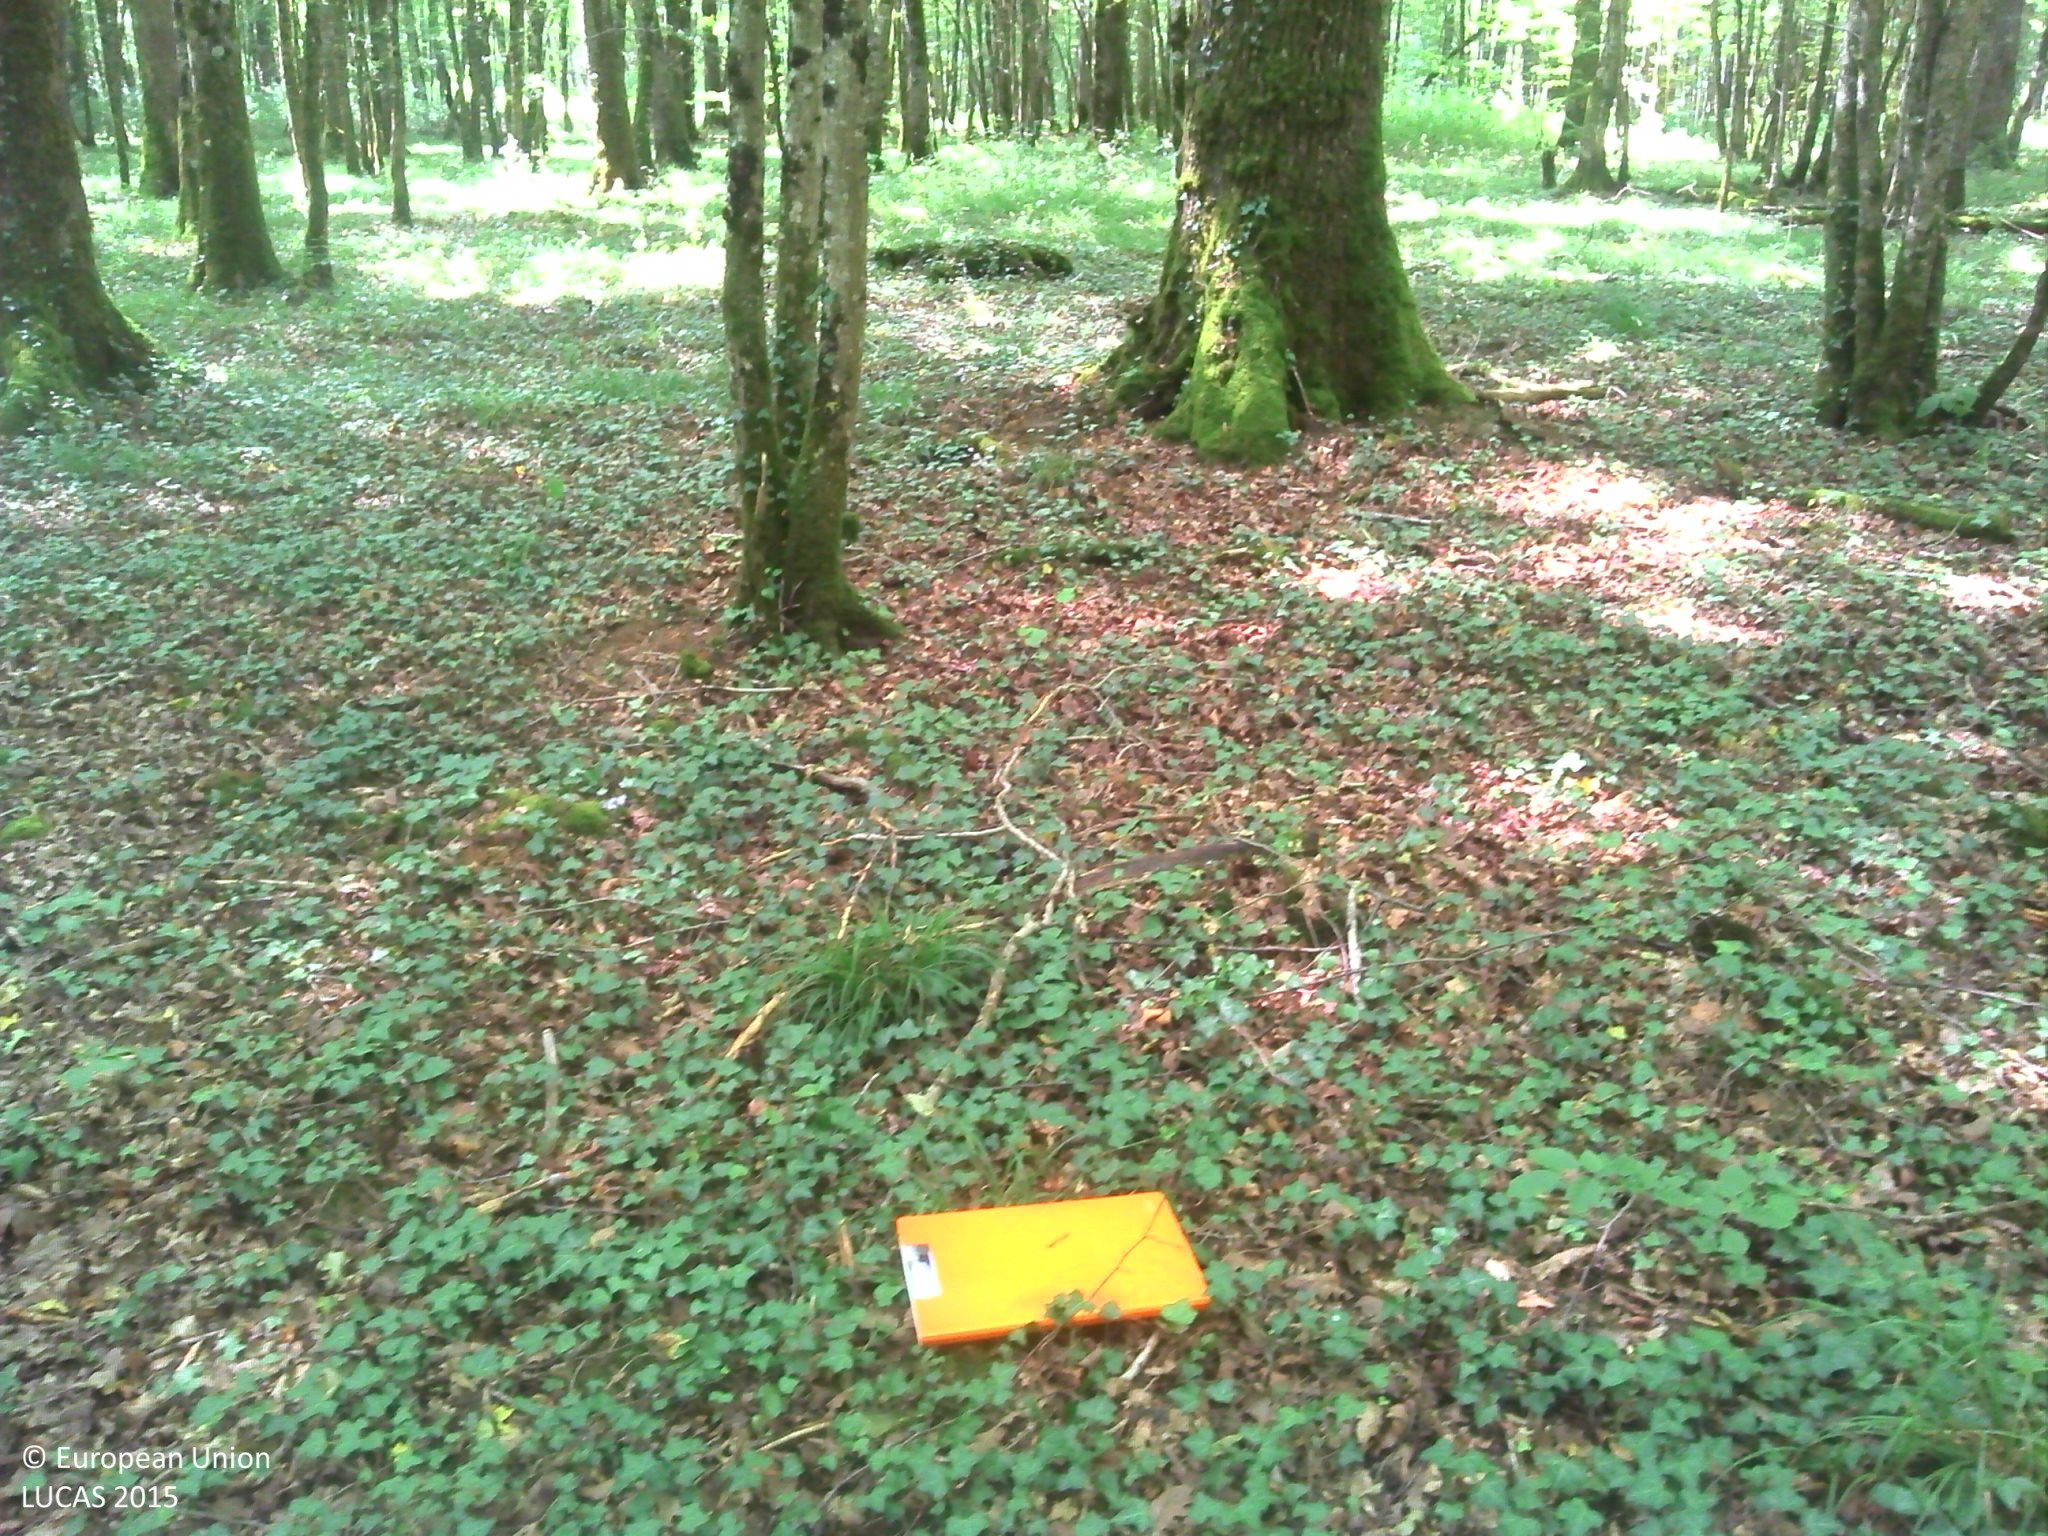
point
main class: Woodland
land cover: Broadleaved woodland
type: acidophilous oak and oak-birch forest
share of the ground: > 75 %
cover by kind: broadleaved forest trees 85 %, herbaceous plants 10 %, lichens and mosses 5 %
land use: Forestry
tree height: > 5 m
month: July
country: FR
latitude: 47.9828
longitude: 4.9748
